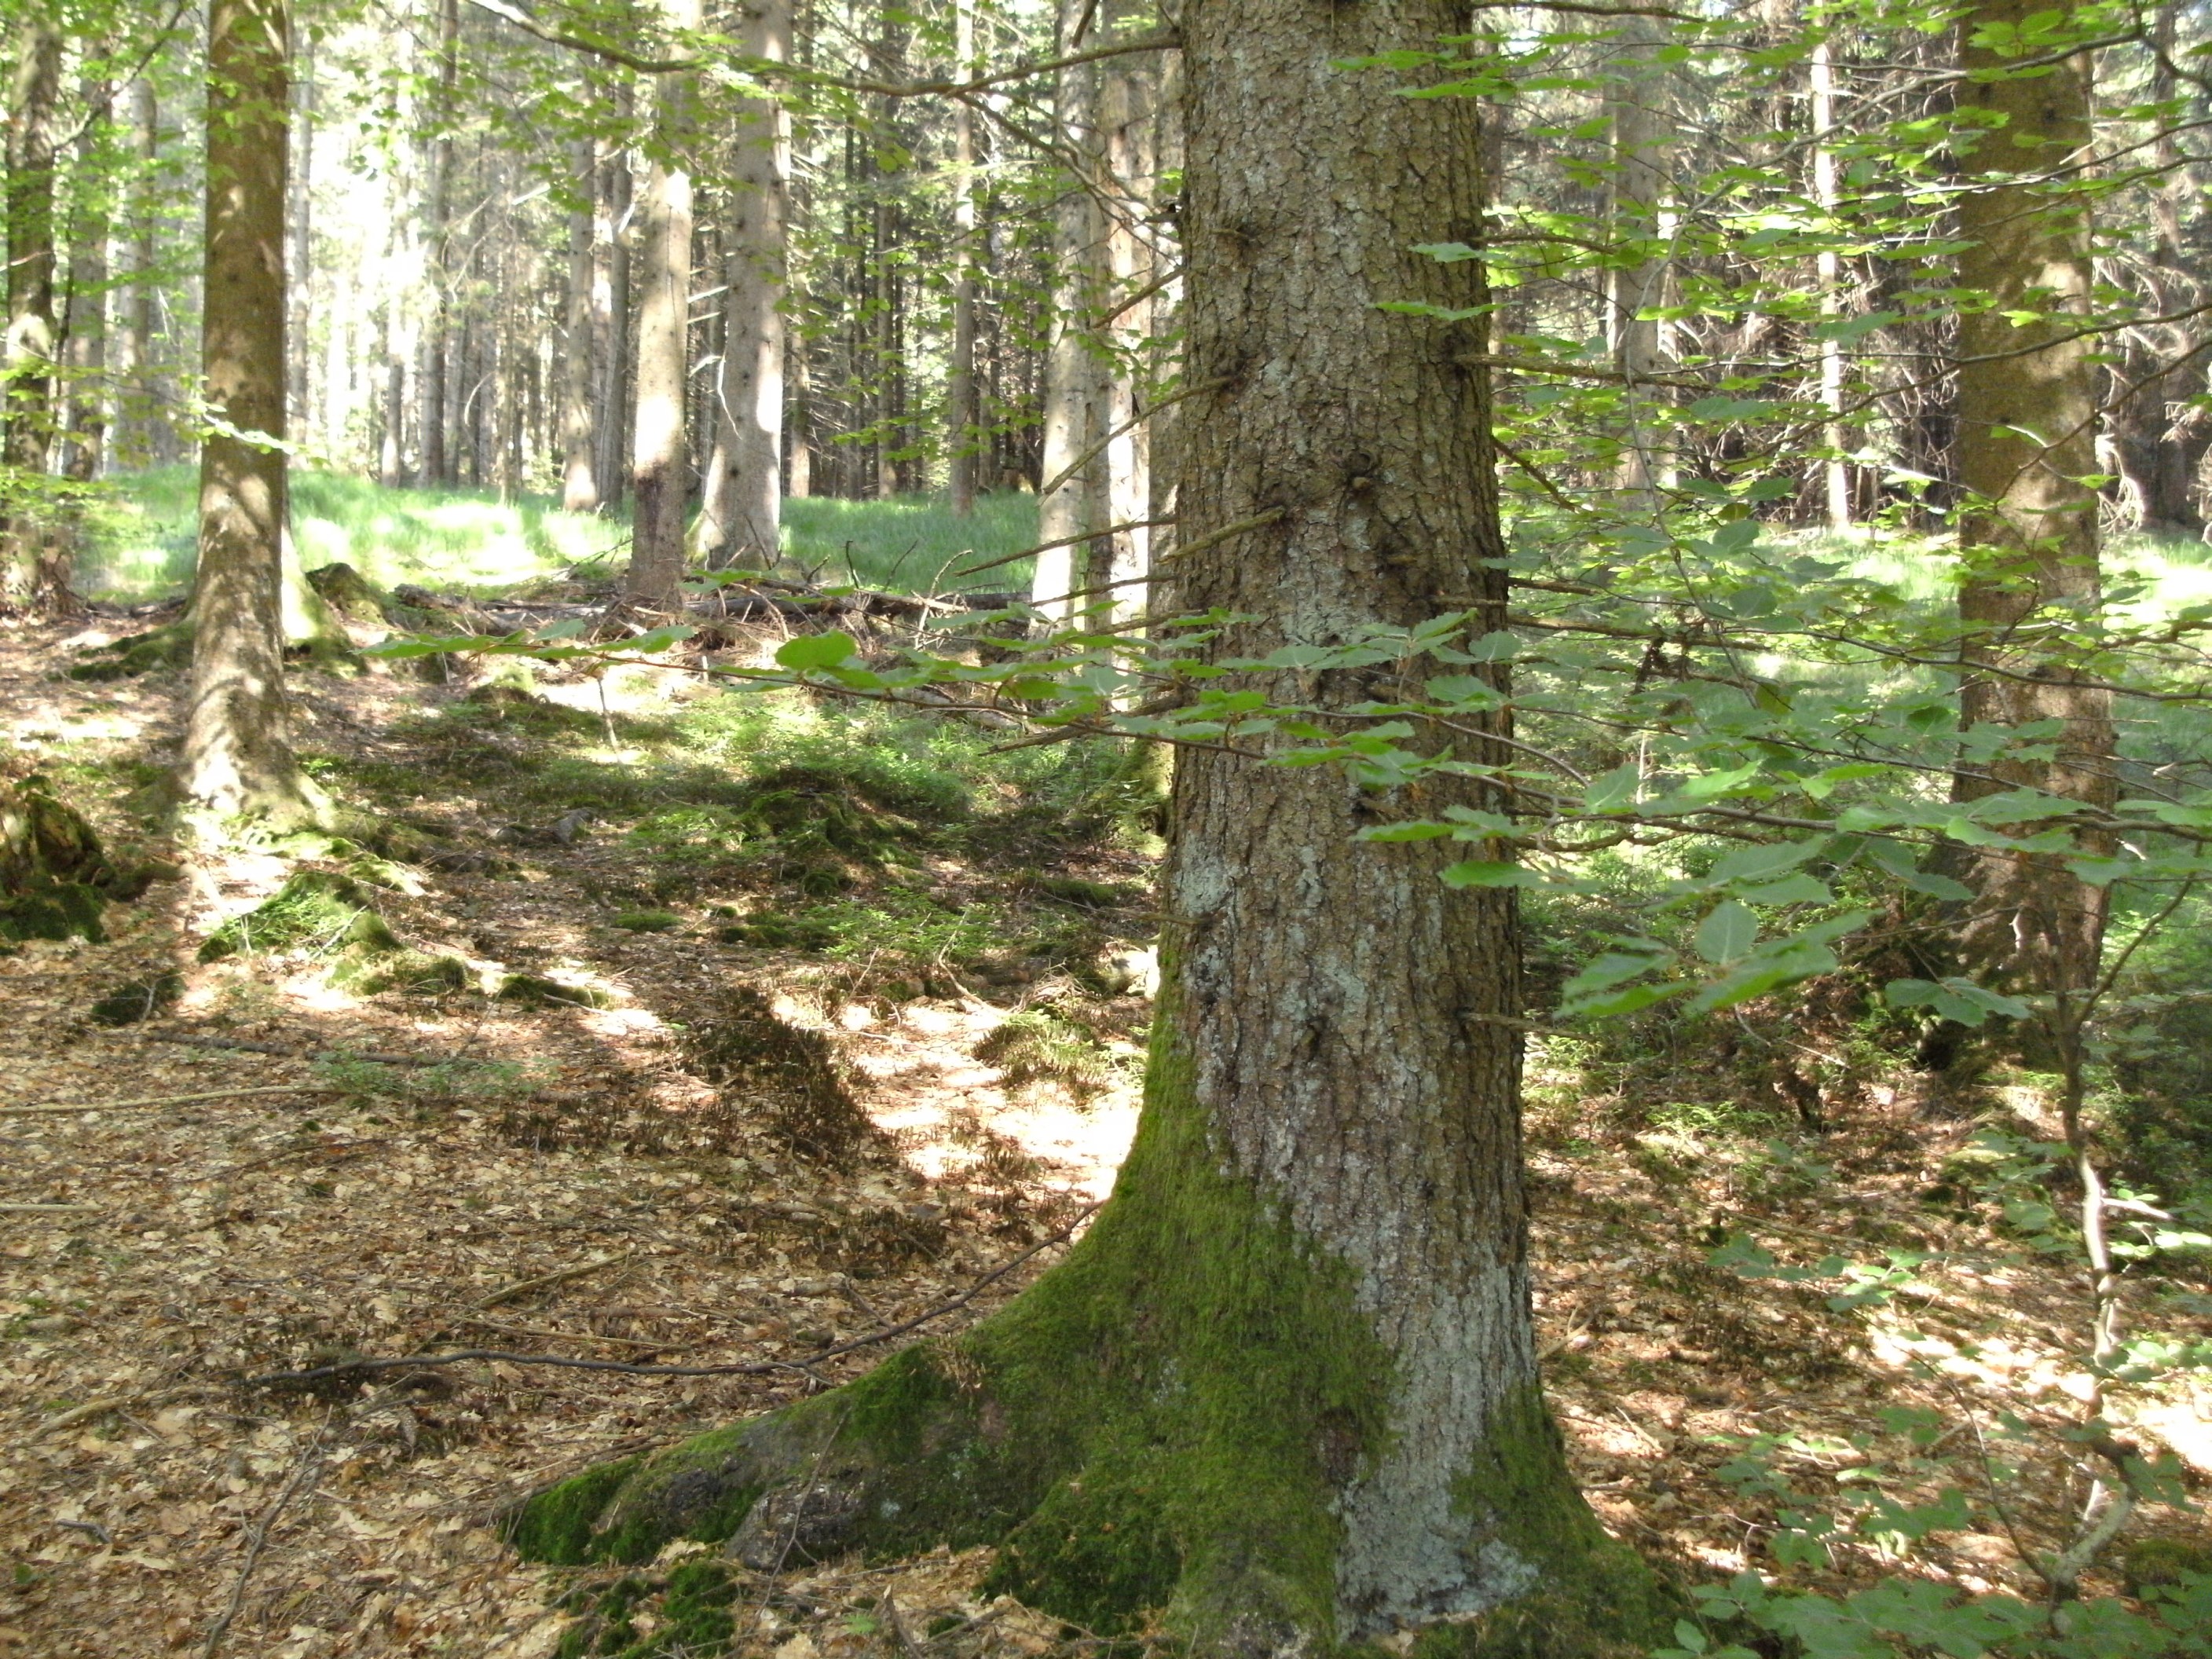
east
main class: Woodland
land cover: Other mixed woodland
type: hemiboreal forest and nemoral coniferous forest and mixed broadleaved-coniferous forest
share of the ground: > 75 %
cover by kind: broadleaved forest trees 55 %, coniferous forest trees 35 %, herbaceous plants 5 %, lichens and mosses 5 %
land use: Forestry
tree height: > 5 m
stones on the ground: < 10 %
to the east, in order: Other mixed woodland; Rivers and streams; Spruce dominated mixed woodland; Spruce dominated coniferous woodland; Spruce dominated mixed woodland; Tracks; Spruce dominated mixed woodland; Grass margins; Ditches and canals; Grass margins; Paved roads, cycling and walking lanes; Grass margins; Ditches and canals; Grass margins; Spruce dominated coniferous woodland; Tracks; Spruce dominated coniferous woodland; Tracks; Spruce dominated coniferous woodland
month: June
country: AT
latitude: 48.0829
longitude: 13.3416
